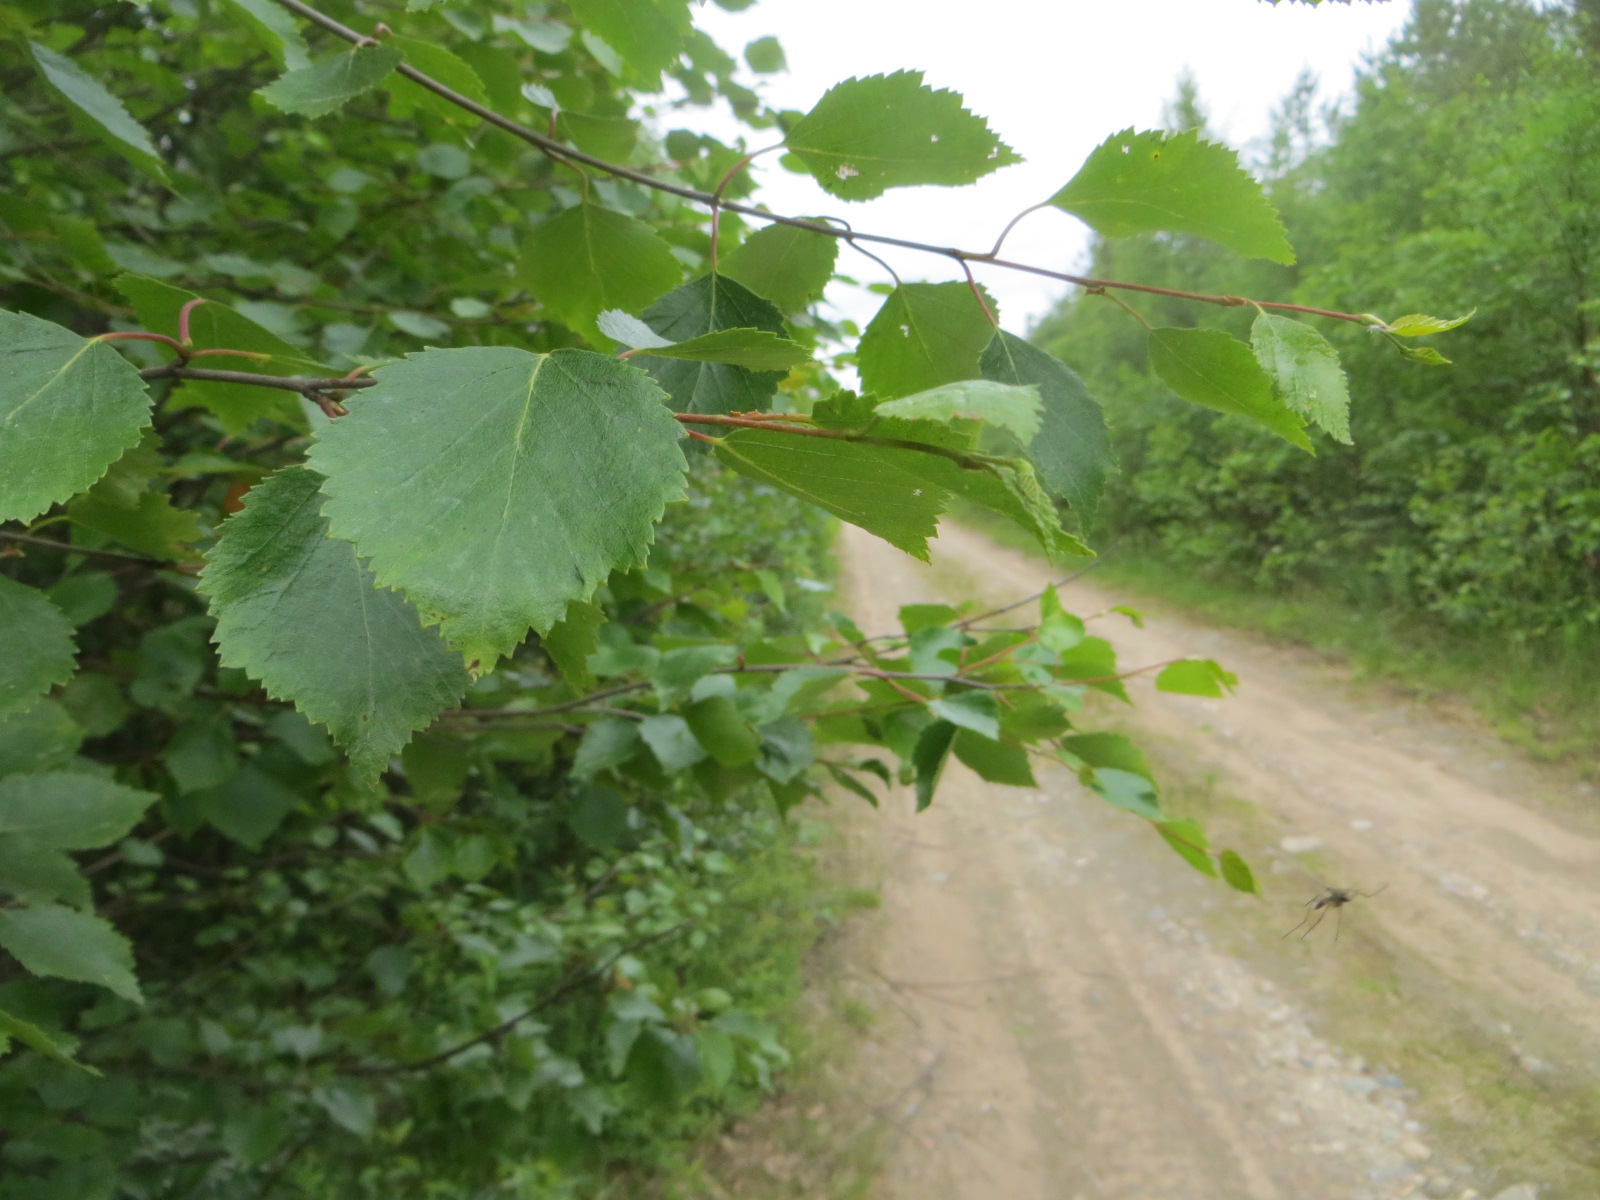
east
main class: Woodland
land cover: Broadleaved woodland
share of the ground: > 75 %
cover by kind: broadleaved forest trees 90 %, coniferous forest trees 5 %, herbaceous plants 5 %
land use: Forestry
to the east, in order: Broadleaved woodland; Ditches and canals; Pine dominated mixed woodland; Ditches and canals; Pine dominated mixed woodland; Ditches and canals; Pine dominated mixed woodland; Ditches and canals; Pine dominated mixed woodland; Pine dominated coniferous woodland
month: June
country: FI
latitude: 65.5887
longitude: 26.6495
